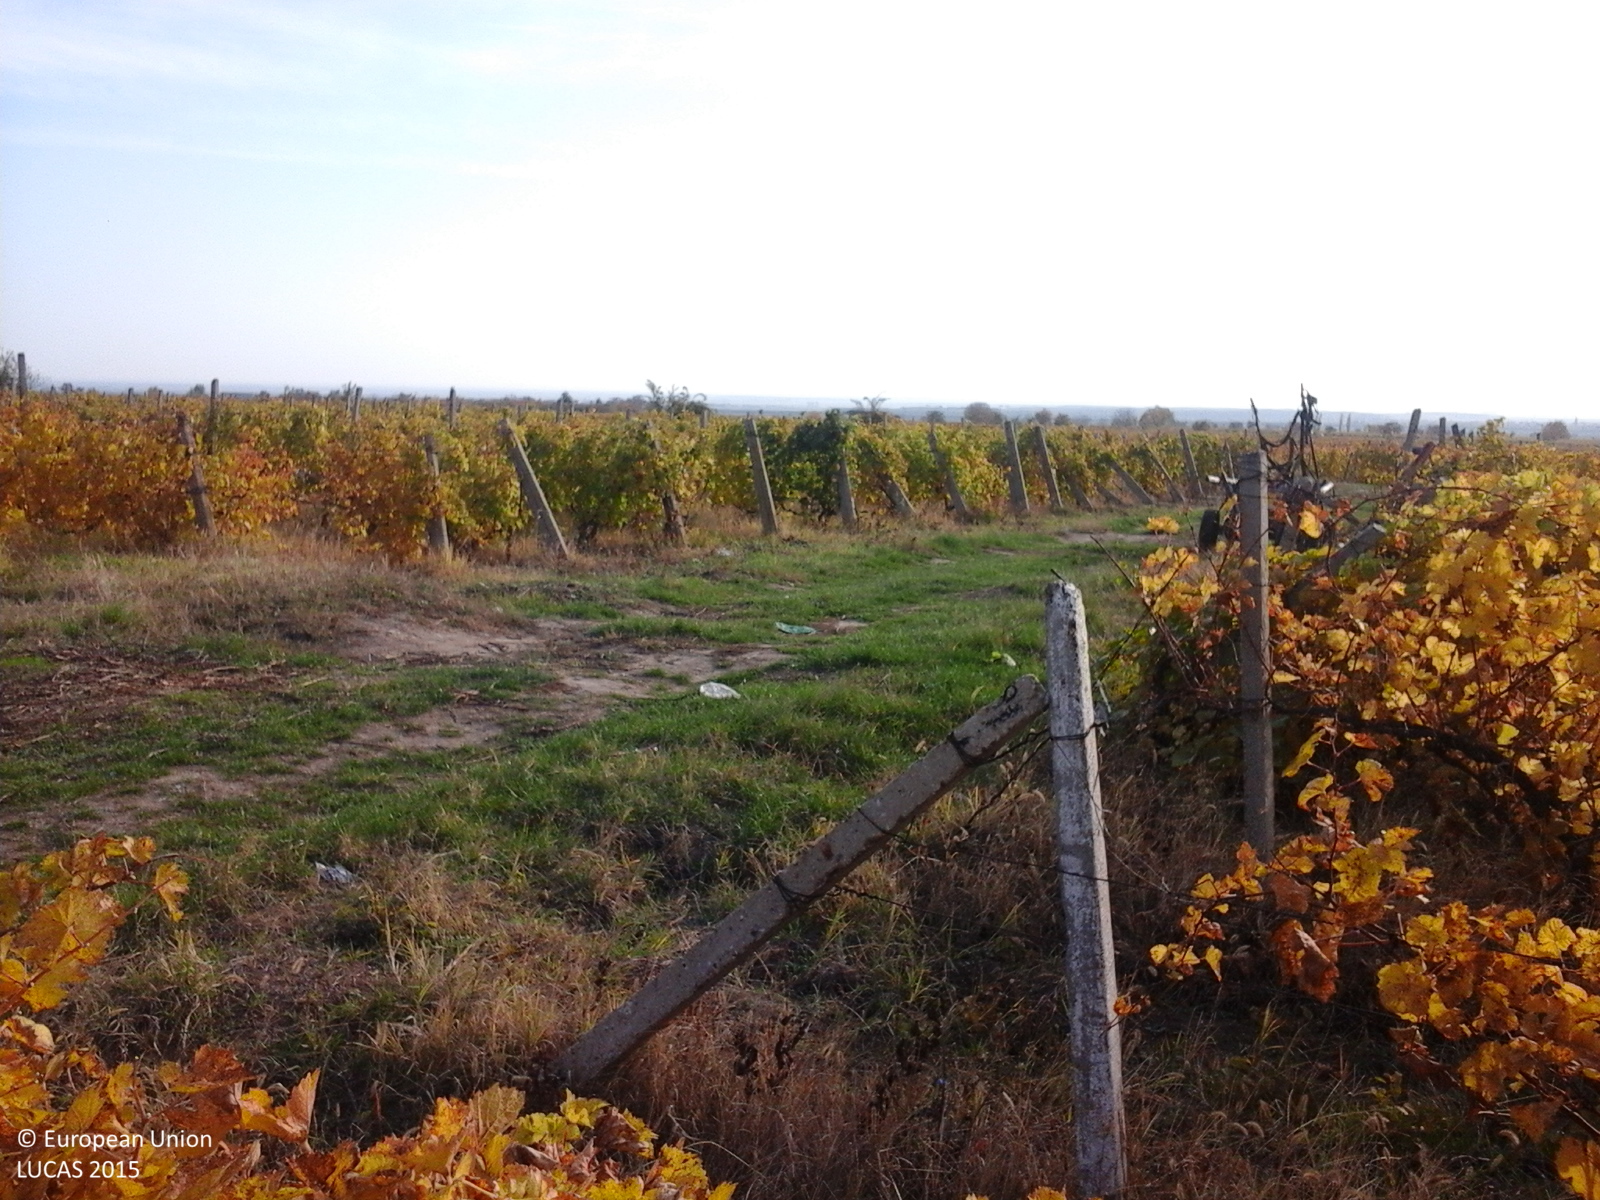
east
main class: Cropland
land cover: Vineyards
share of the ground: > 75 %
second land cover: Grassland without tree/shrub cover
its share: > 75 %
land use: Agriculture (excluding fallow land and kitchen gardens)
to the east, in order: Vineyards; Grassland without tree/shrub cover; Grass margins; Tracks; Grass margins; Vineyards; Shruby margins; Tracks; Shruby margins; Vineyards
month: October
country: RO
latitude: 45.5166
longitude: 27.0777
